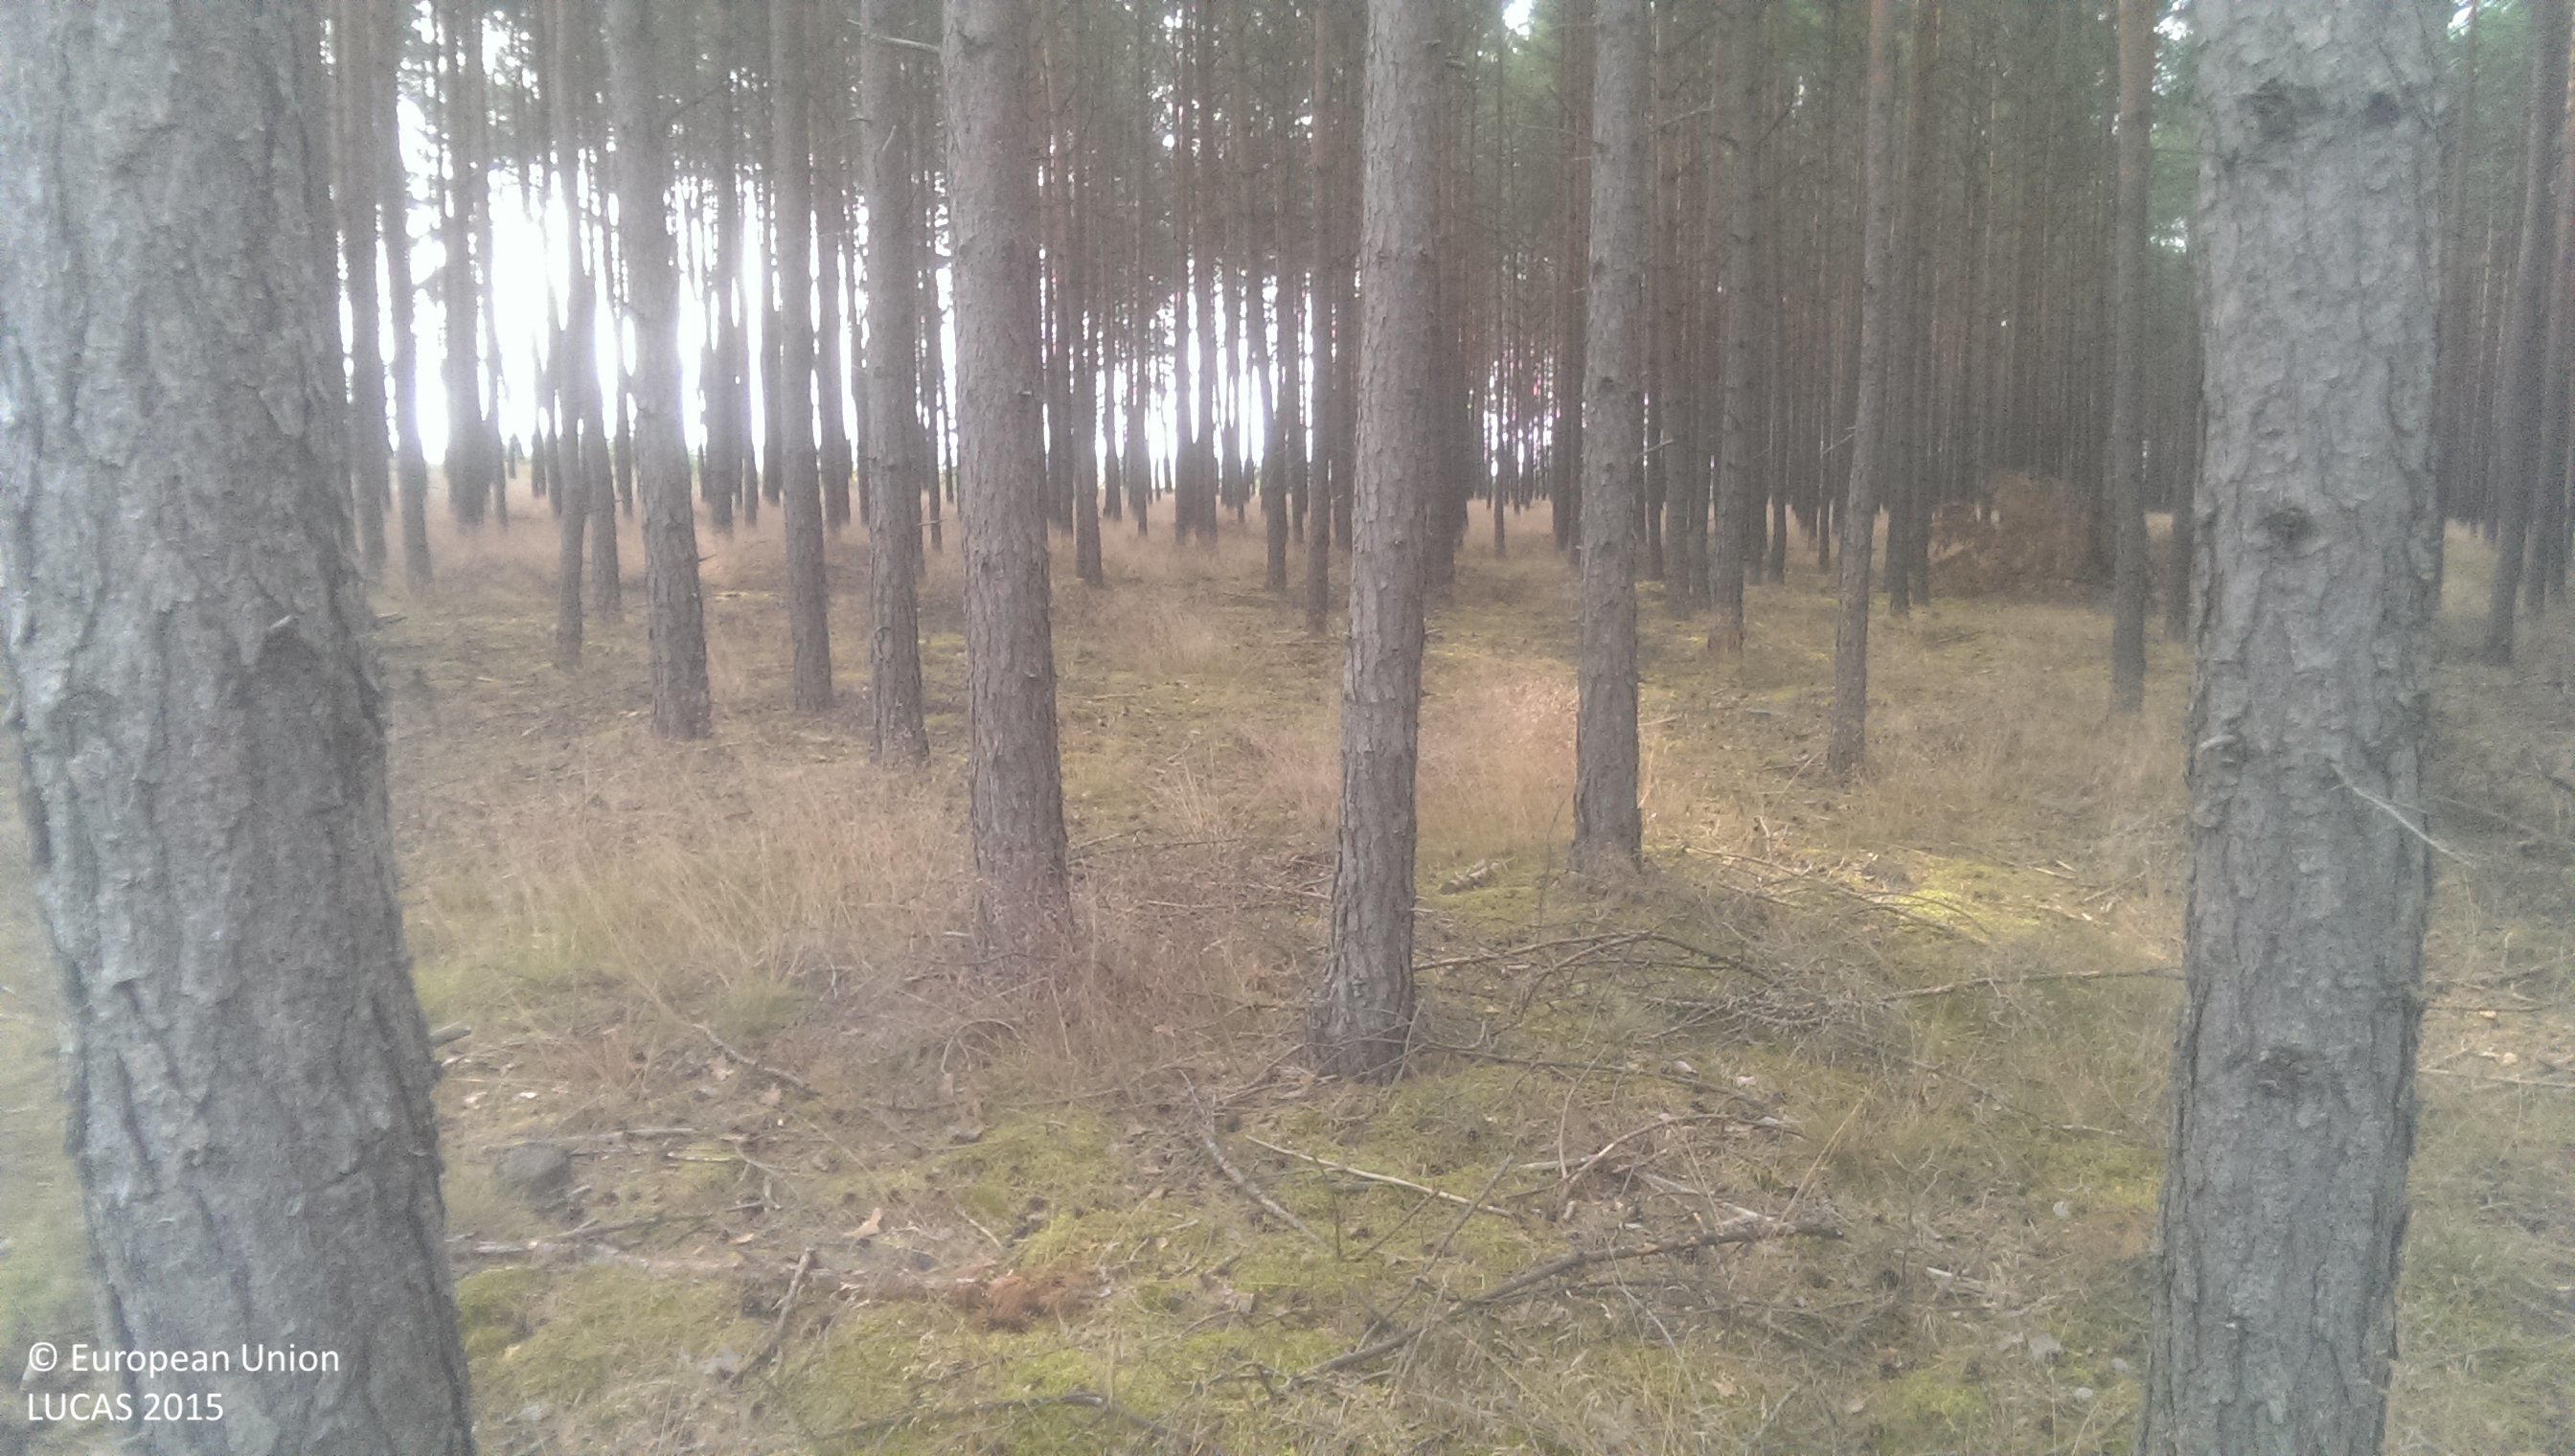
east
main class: Woodland
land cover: Pine dominated coniferous woodland
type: hemiboreal forest and nemoral coniferous forest and mixed broadleaved-coniferous forest
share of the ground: 50 - 75 %
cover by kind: coniferous forest trees 70 %, lichens and mosses 20 %, herbaceous plants 10 %
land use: Forestry
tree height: > 5 m
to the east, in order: Pine dominated coniferous woodland; Grass margins; Triticale
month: July
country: PL
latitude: 52.3701
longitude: 15.6297
